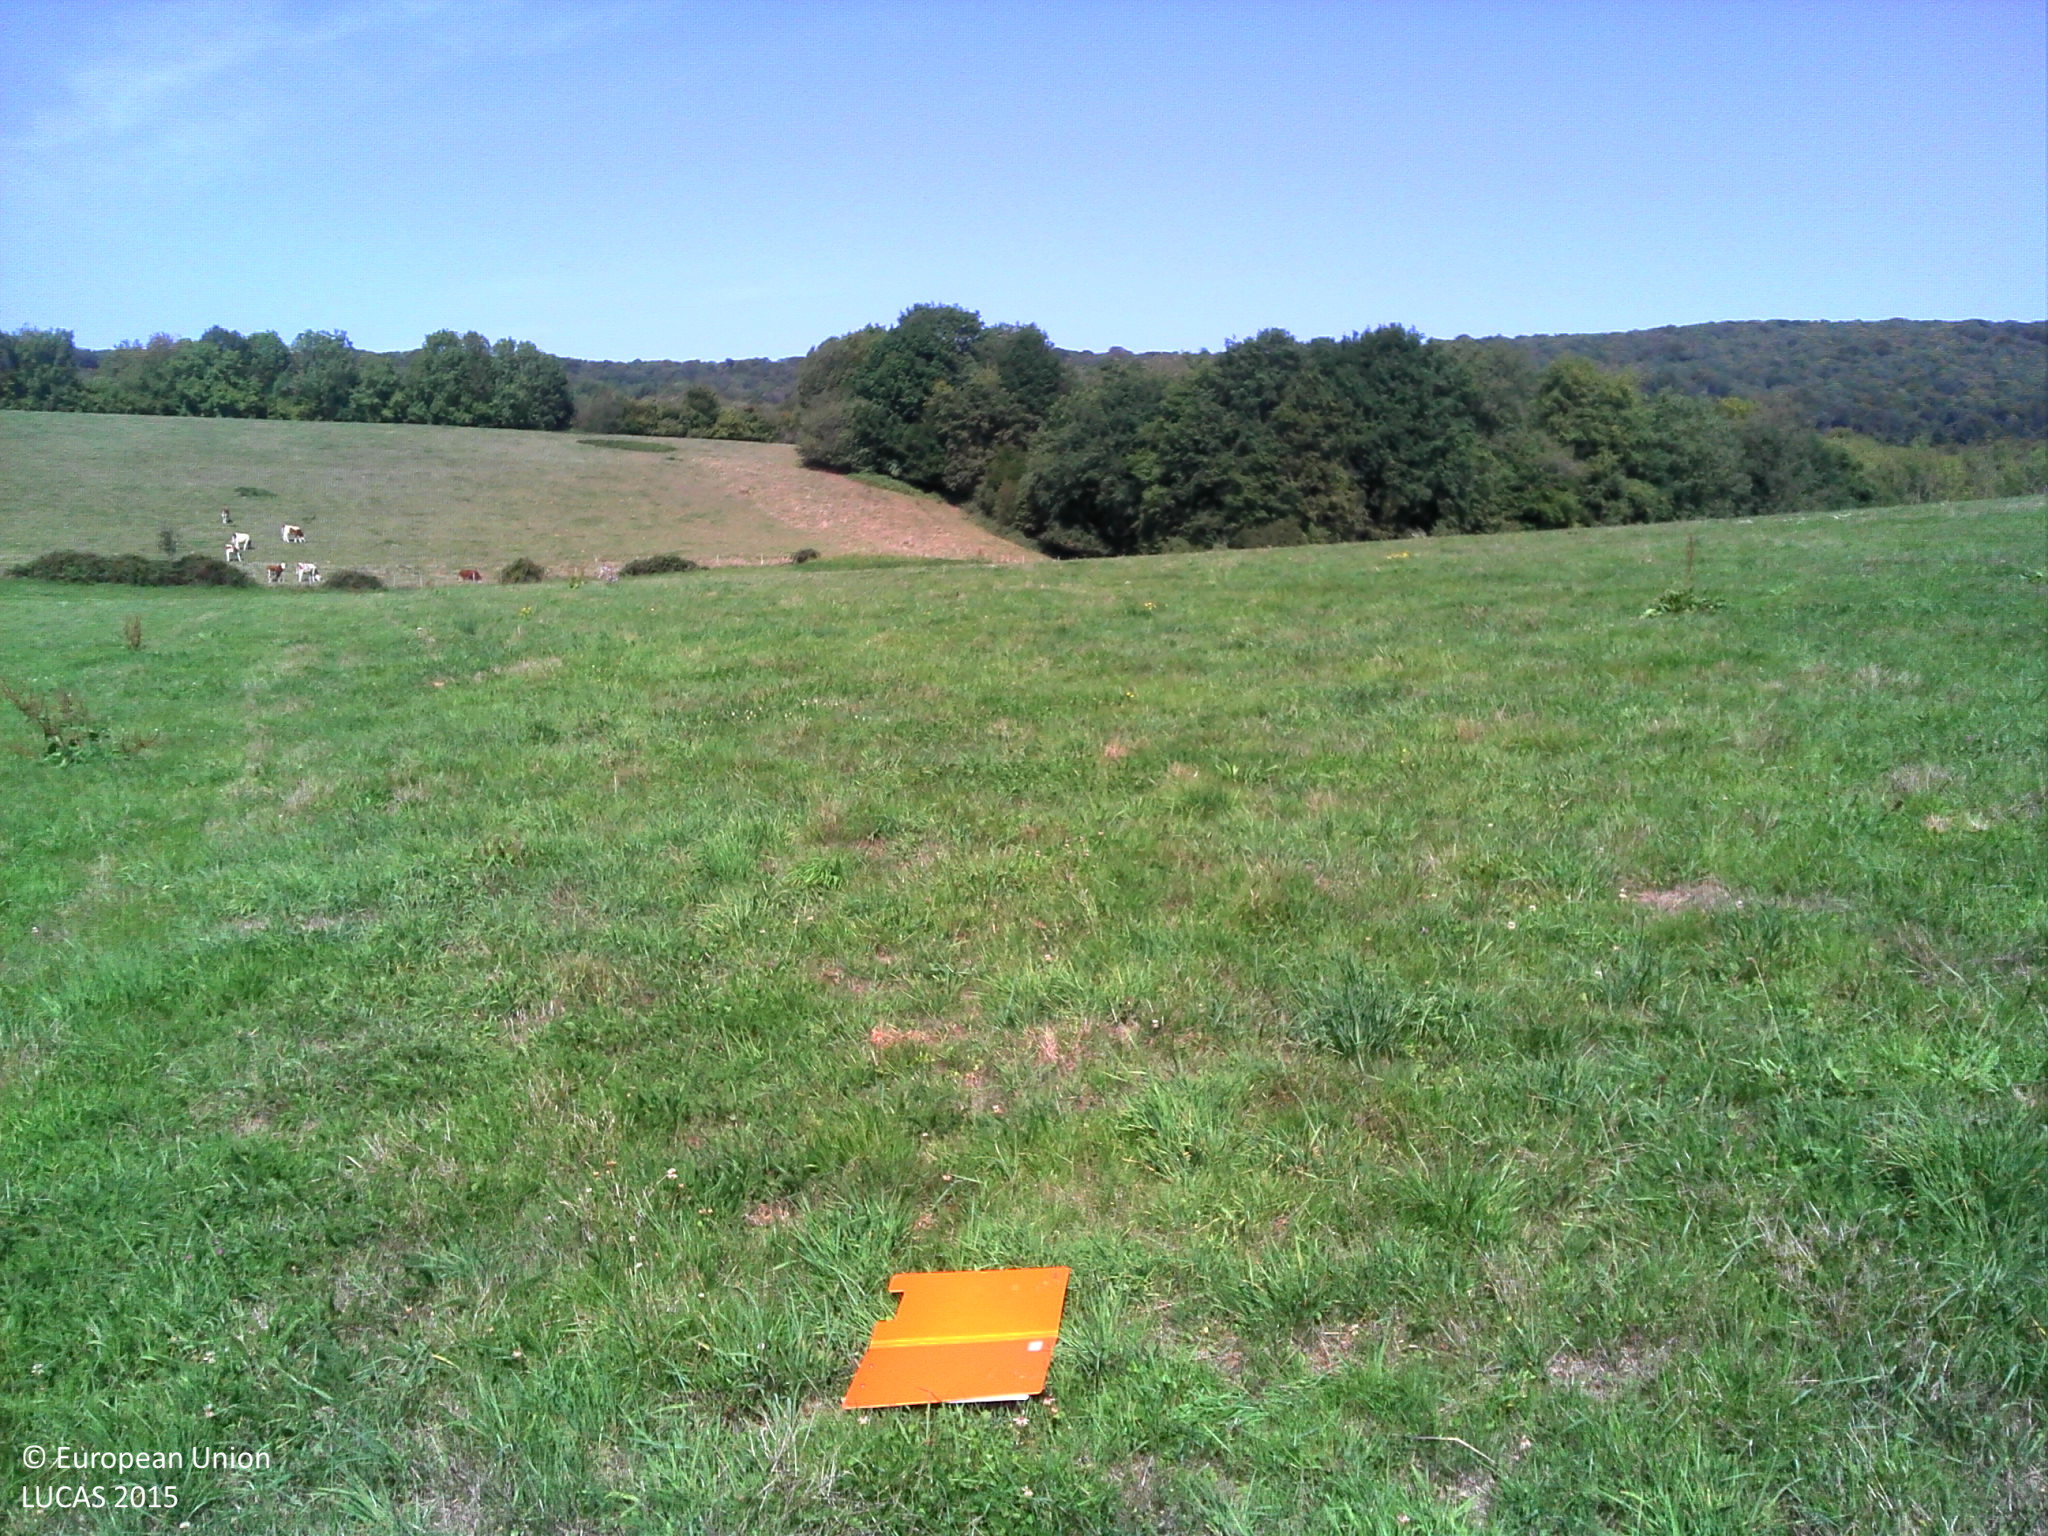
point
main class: Grassland
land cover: Grassland without tree/shrub cover
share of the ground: > 75 %
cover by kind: herbaceous plants 100 %
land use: Agriculture (excluding fallow land and kitchen gardens)
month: September
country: FR
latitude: 47.2868
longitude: 6.0219
